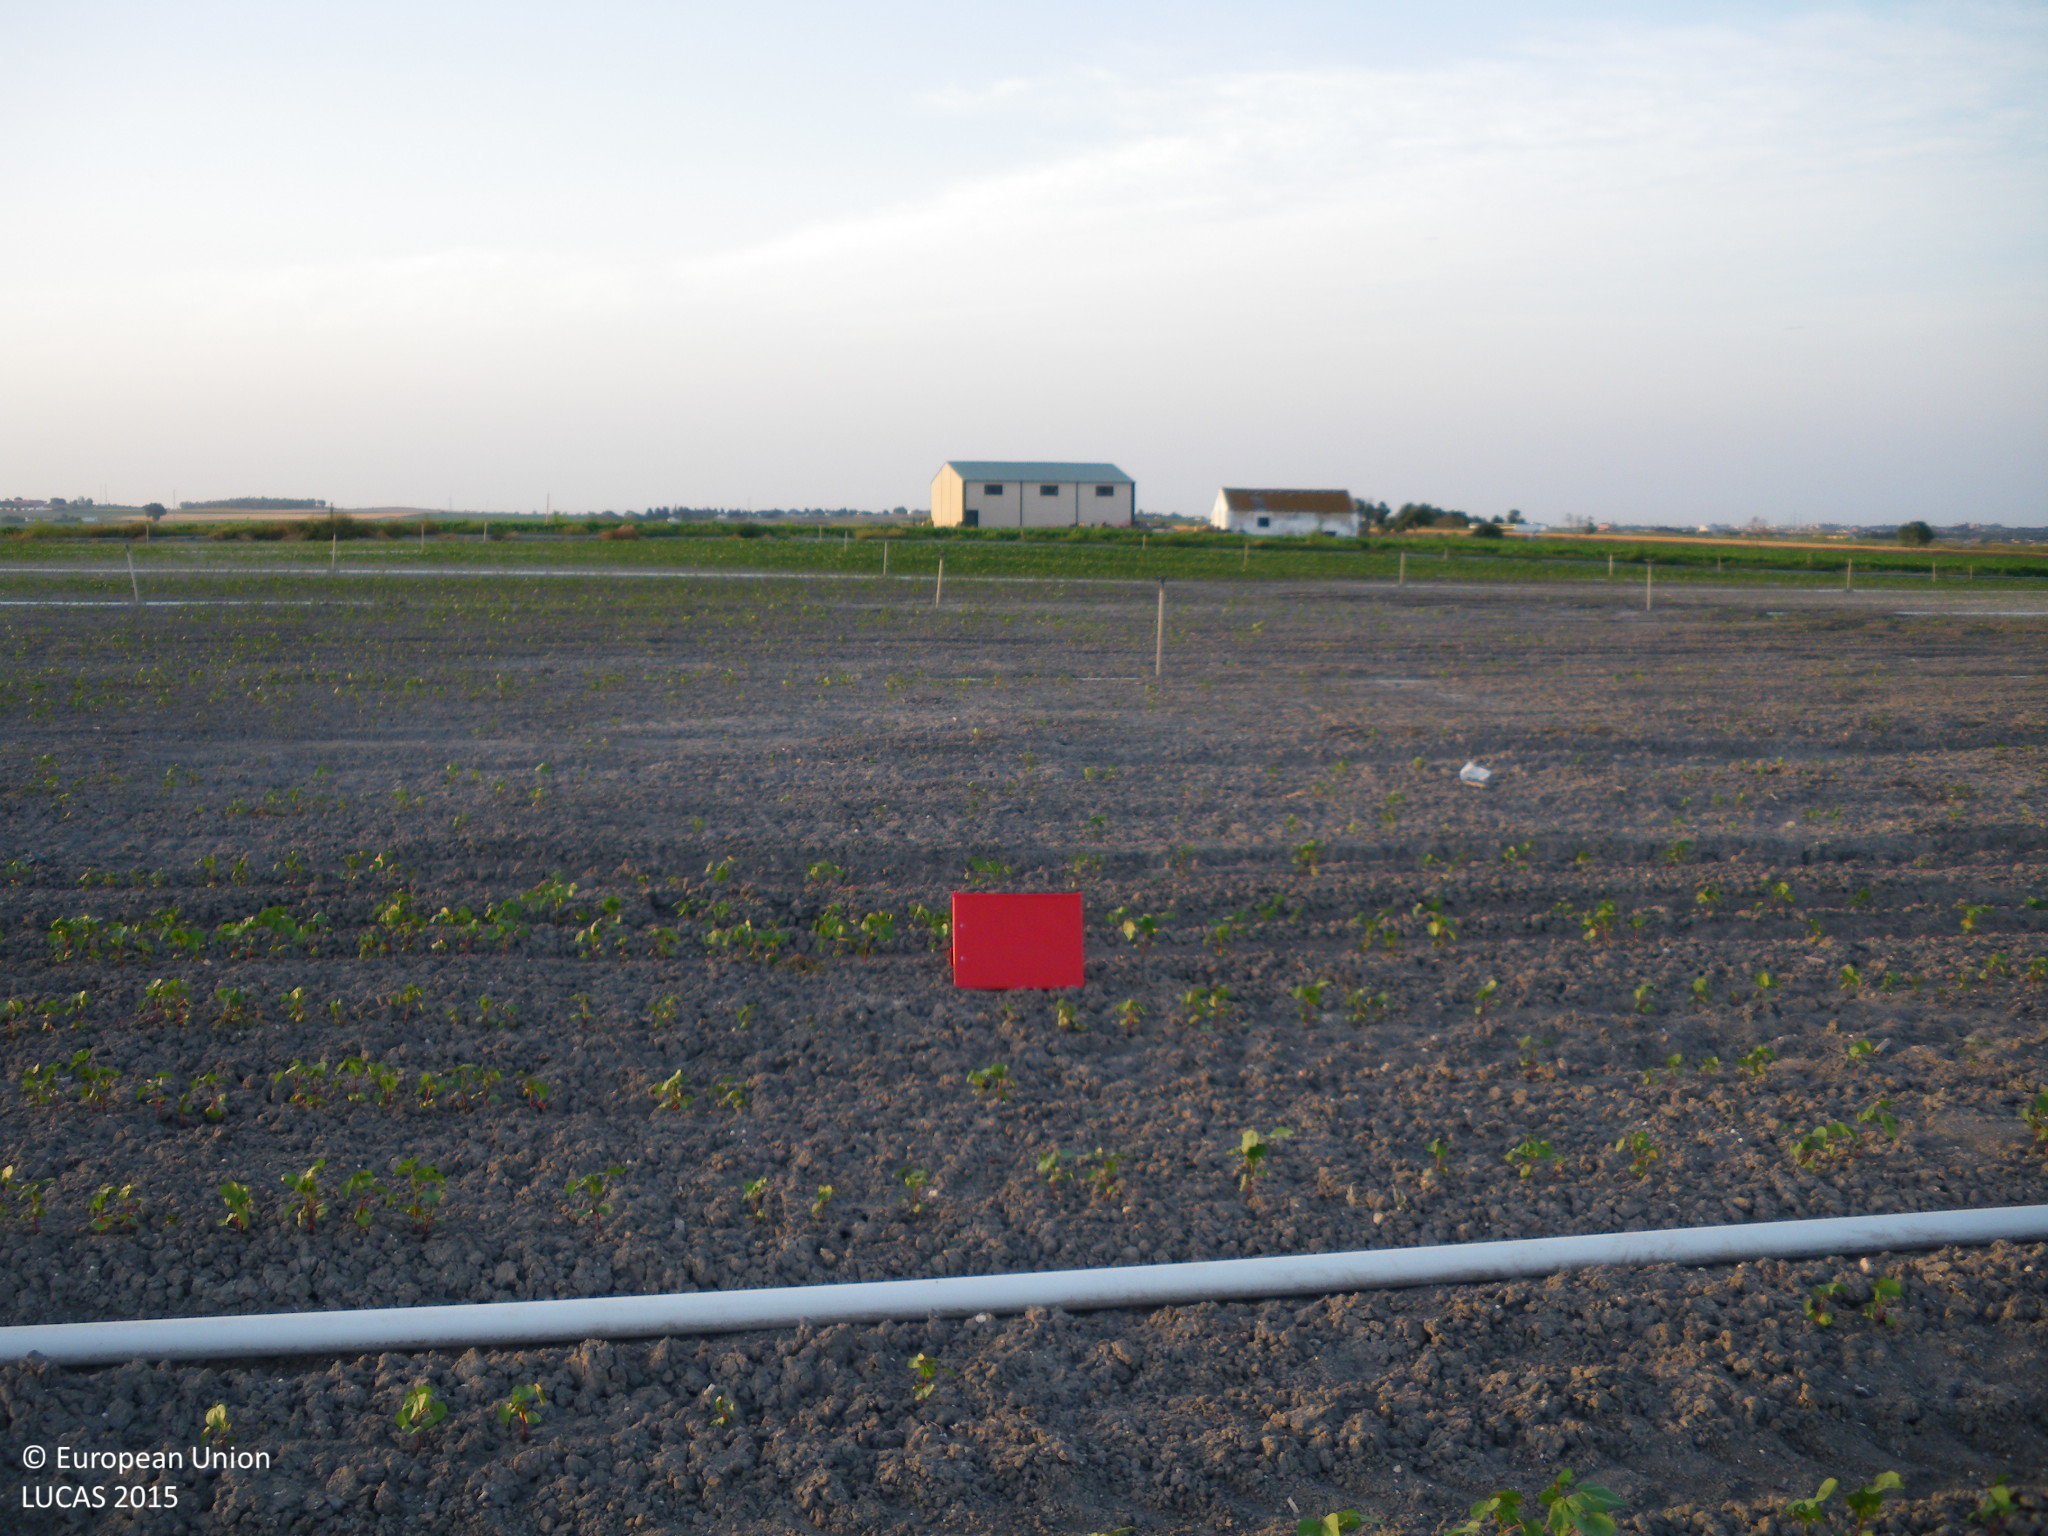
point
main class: Cropland
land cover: Cotton
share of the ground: < 10 %
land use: Agriculture (excluding fallow land and kitchen gardens)
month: June
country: ES
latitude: 36.6543
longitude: -6.2451
